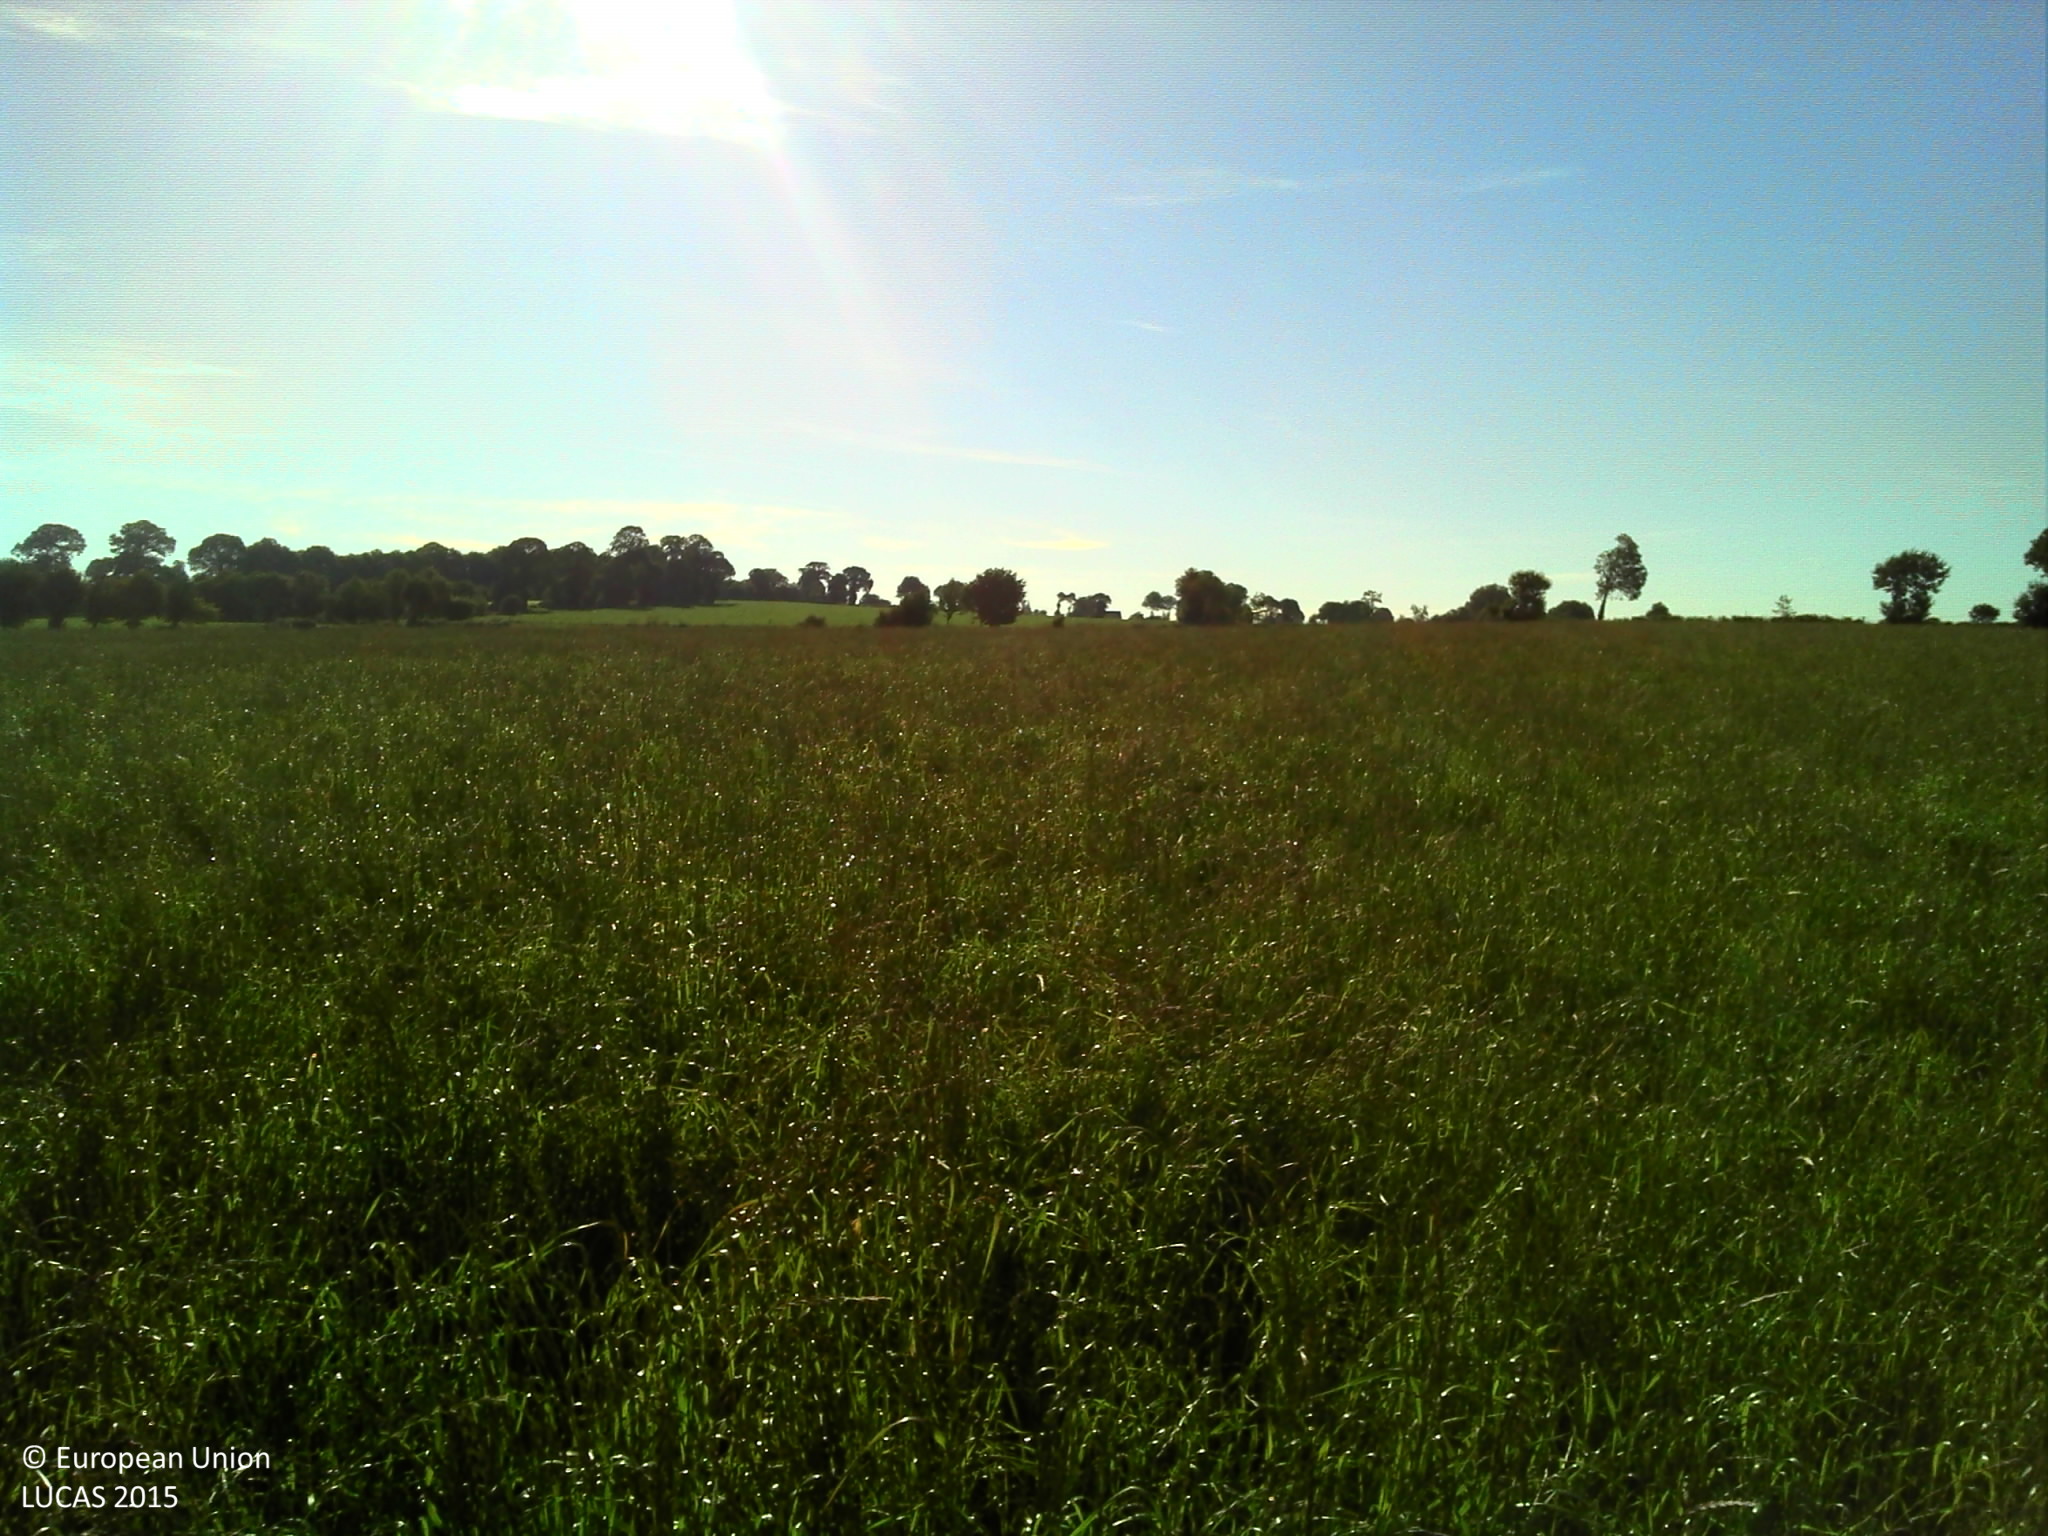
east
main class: Cropland
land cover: Temporary grasslands
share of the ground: > 75 %
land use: Agriculture (excluding fallow land and kitchen gardens)
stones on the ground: < 10 %
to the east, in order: Temporary grasslands; Abandoned hedges; Fences; Grassland without tree/shrub cover
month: June
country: FR
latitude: 48.3711
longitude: -1.2616
